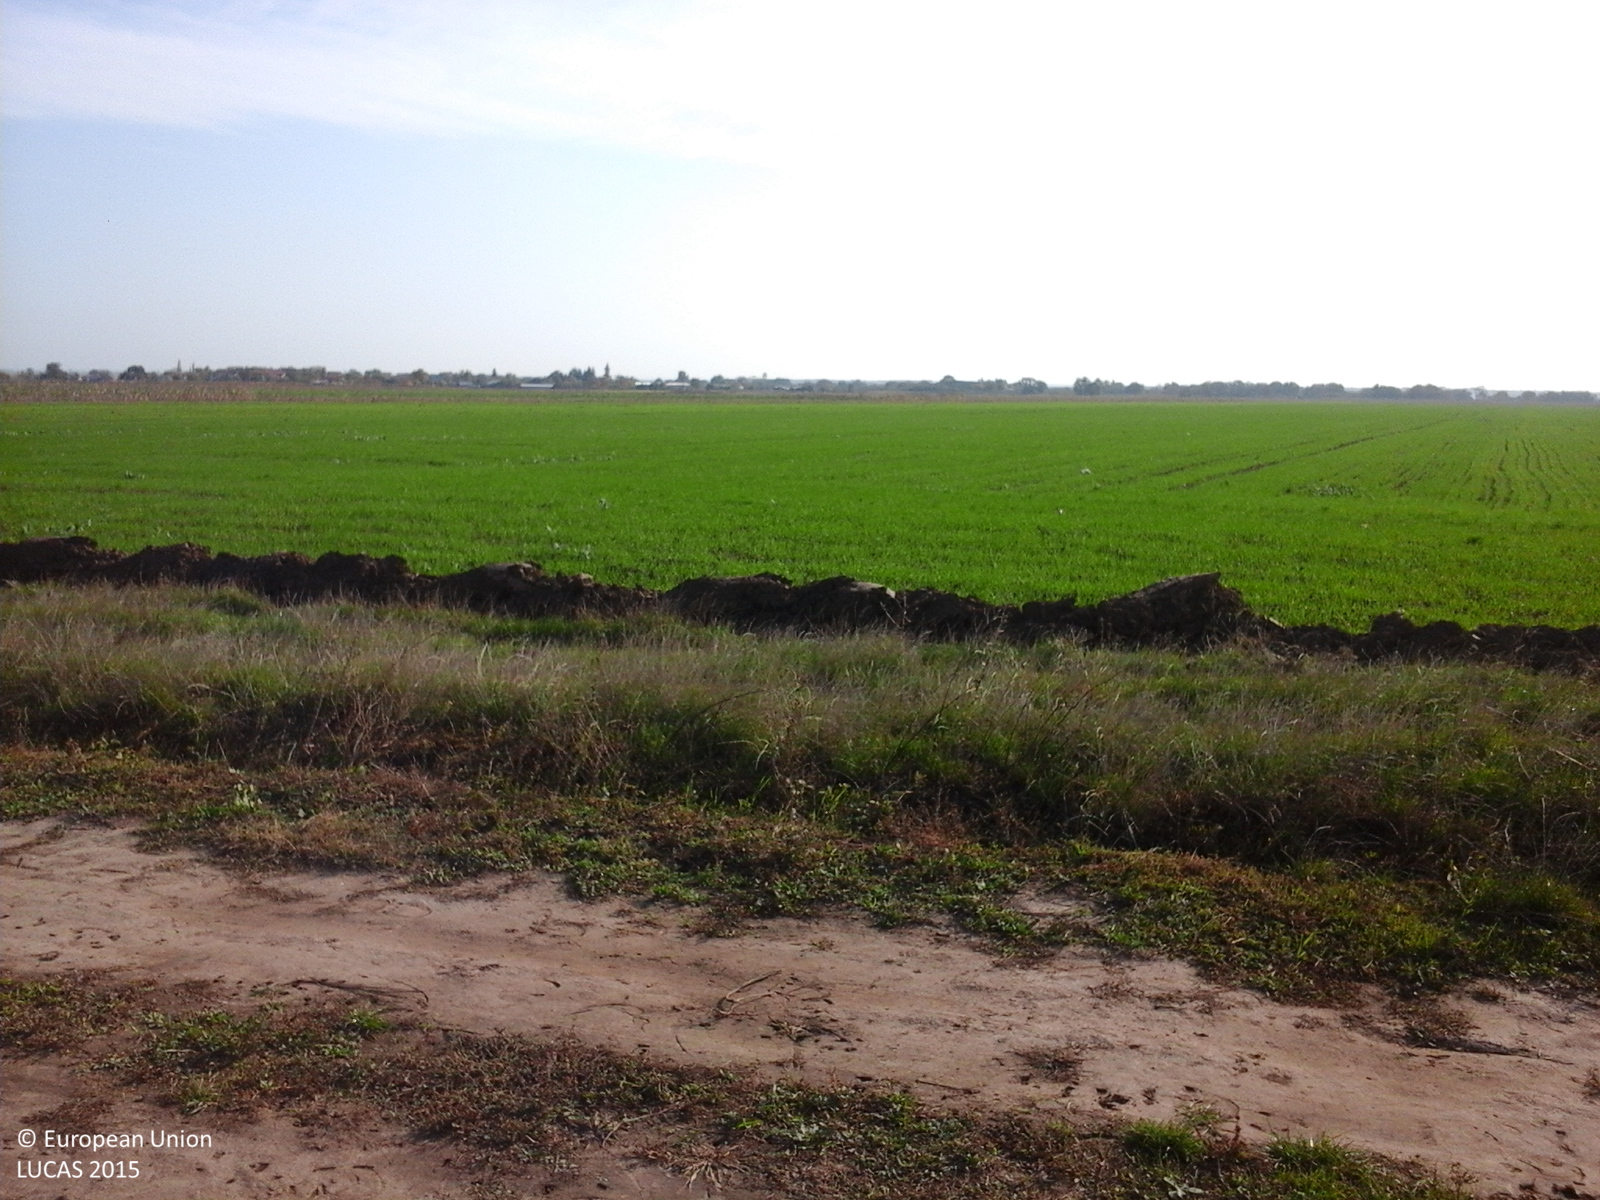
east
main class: Grassland
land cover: Spontaneously vegetated surfaces
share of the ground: > 75 %
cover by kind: herbaceous plants 100 %
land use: Fallow land
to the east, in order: Spontaneously vegetated surfaces; Tracks; Grassland without tree/shrub cover; Common wheat; Maize; Rape and turnip rape
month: October
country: RO
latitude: 45.5258
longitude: 27.1333
